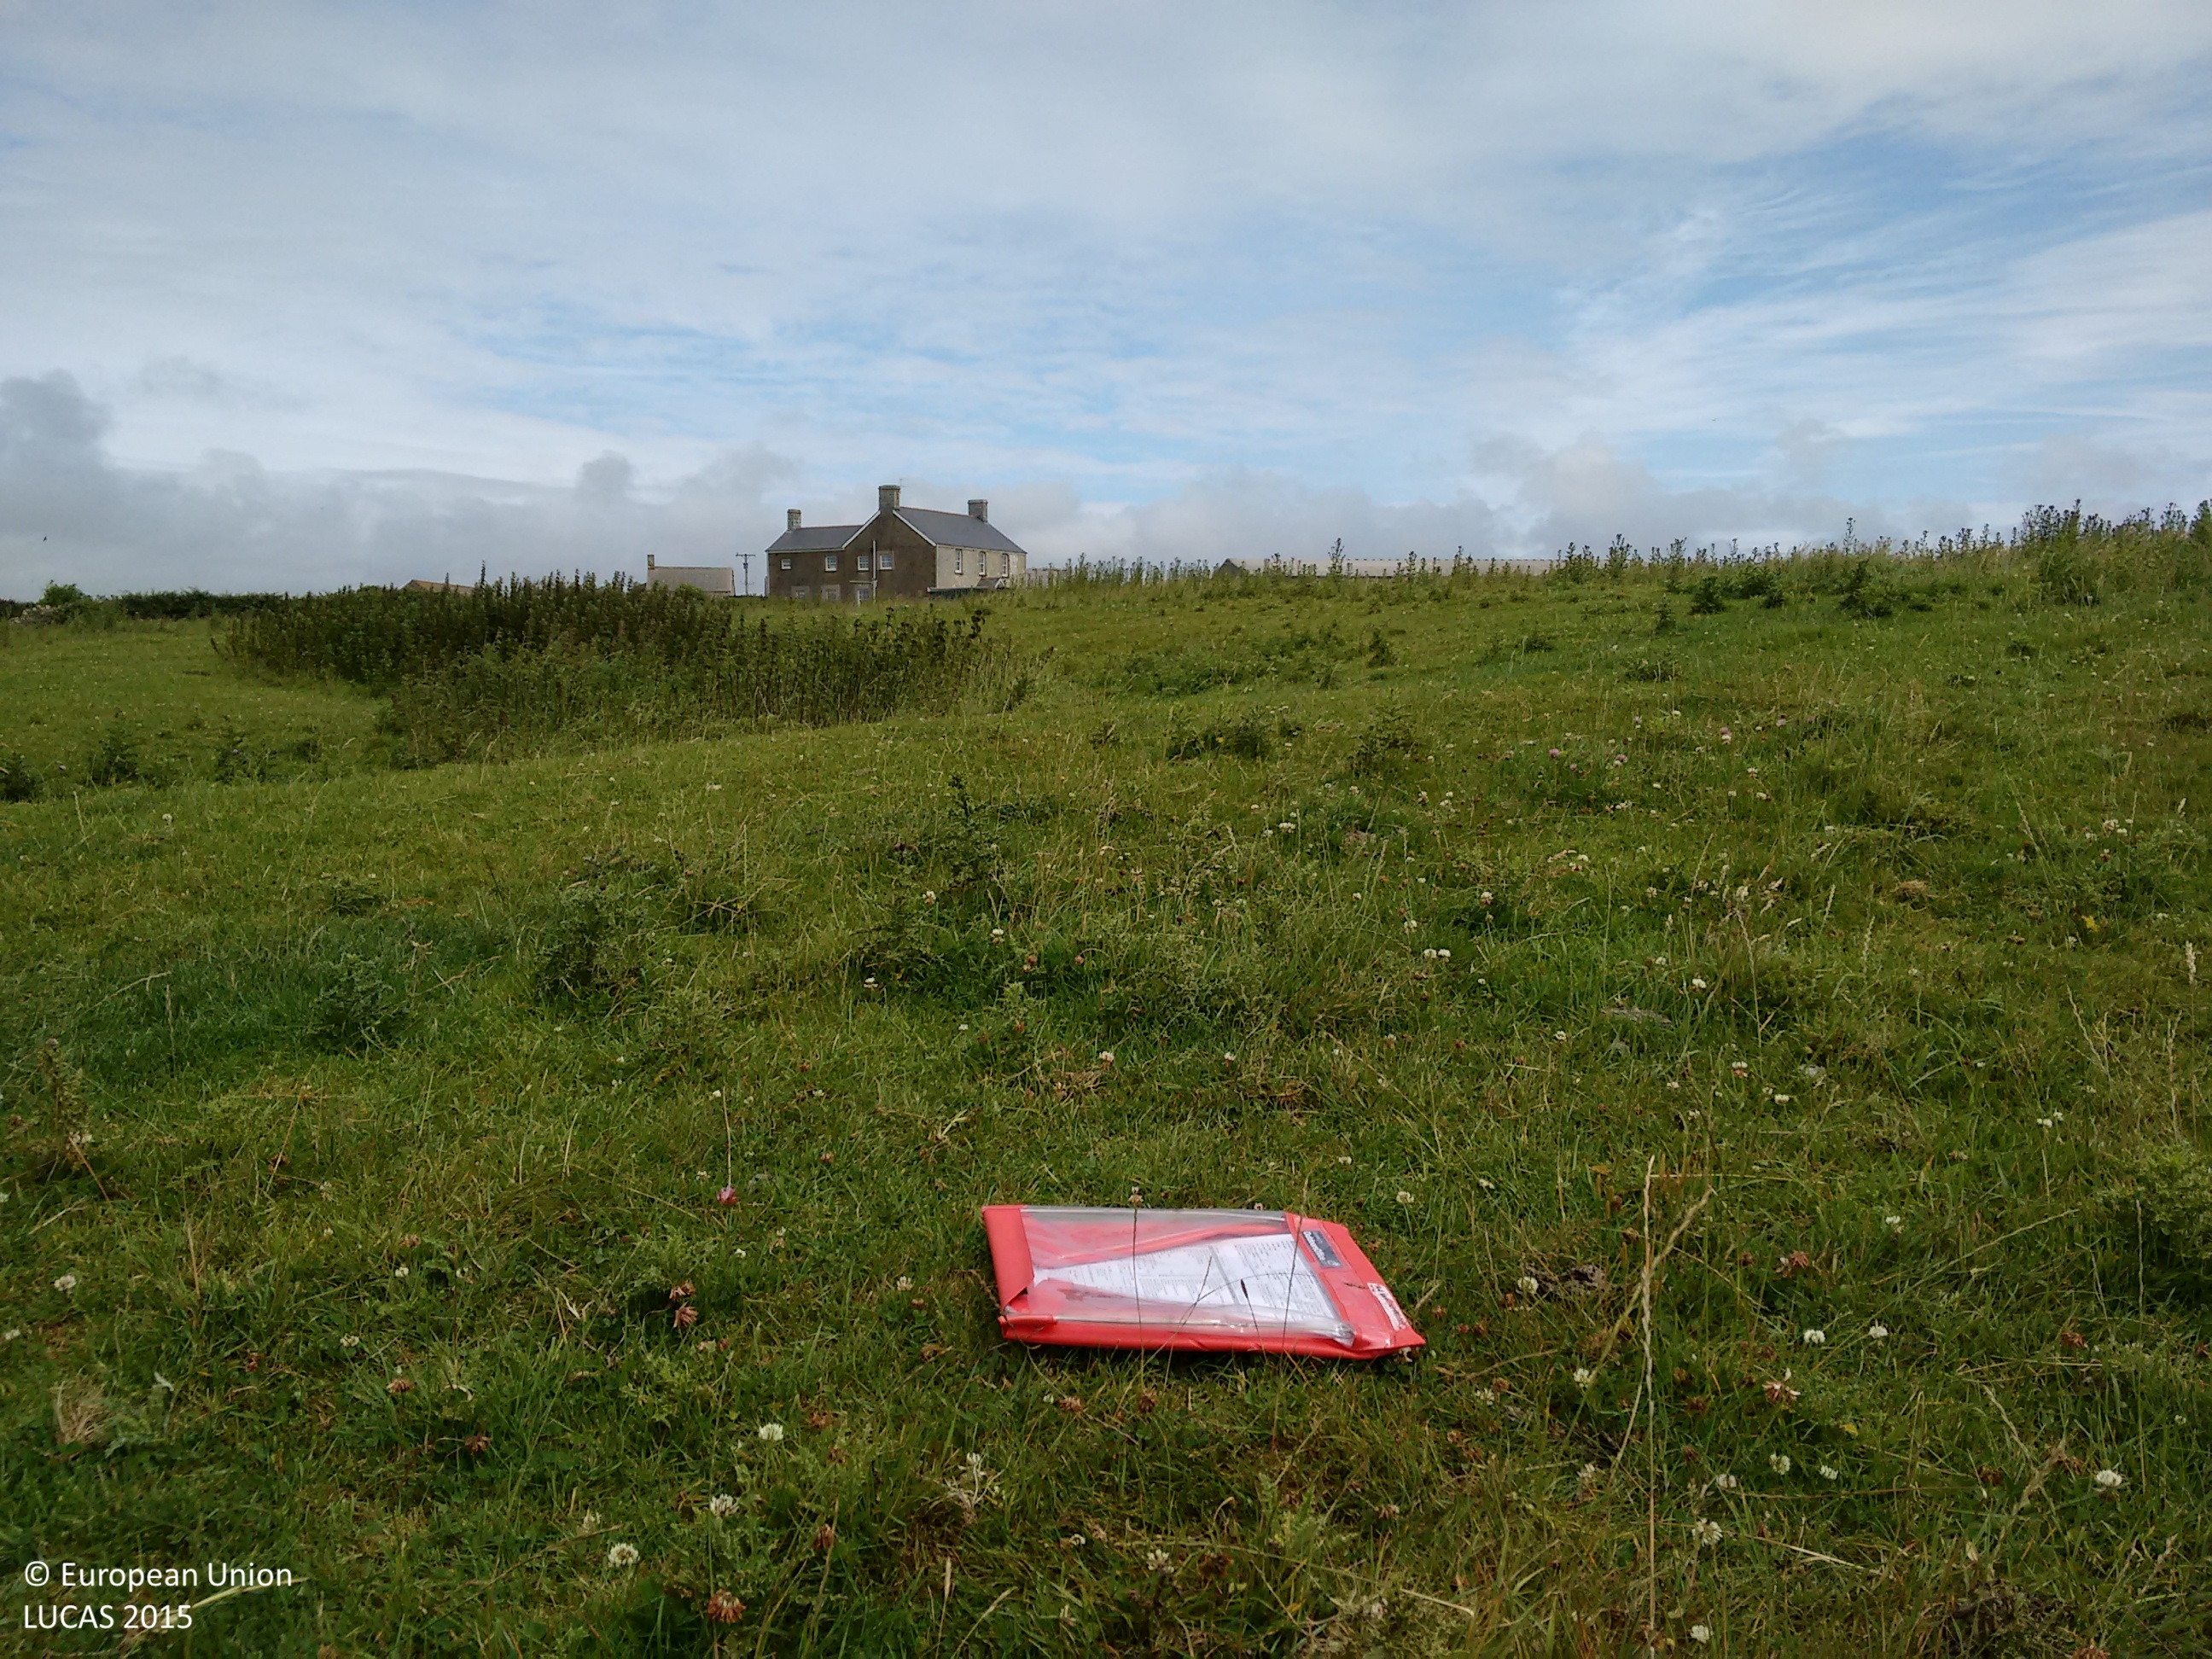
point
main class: Grassland
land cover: Grassland without tree/shrub cover
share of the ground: > 75 %
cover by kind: herbaceous plants 100 %
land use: Agriculture (excluding fallow land and kitchen gardens)
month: July
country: GB
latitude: 51.4125
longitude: -3.5576
